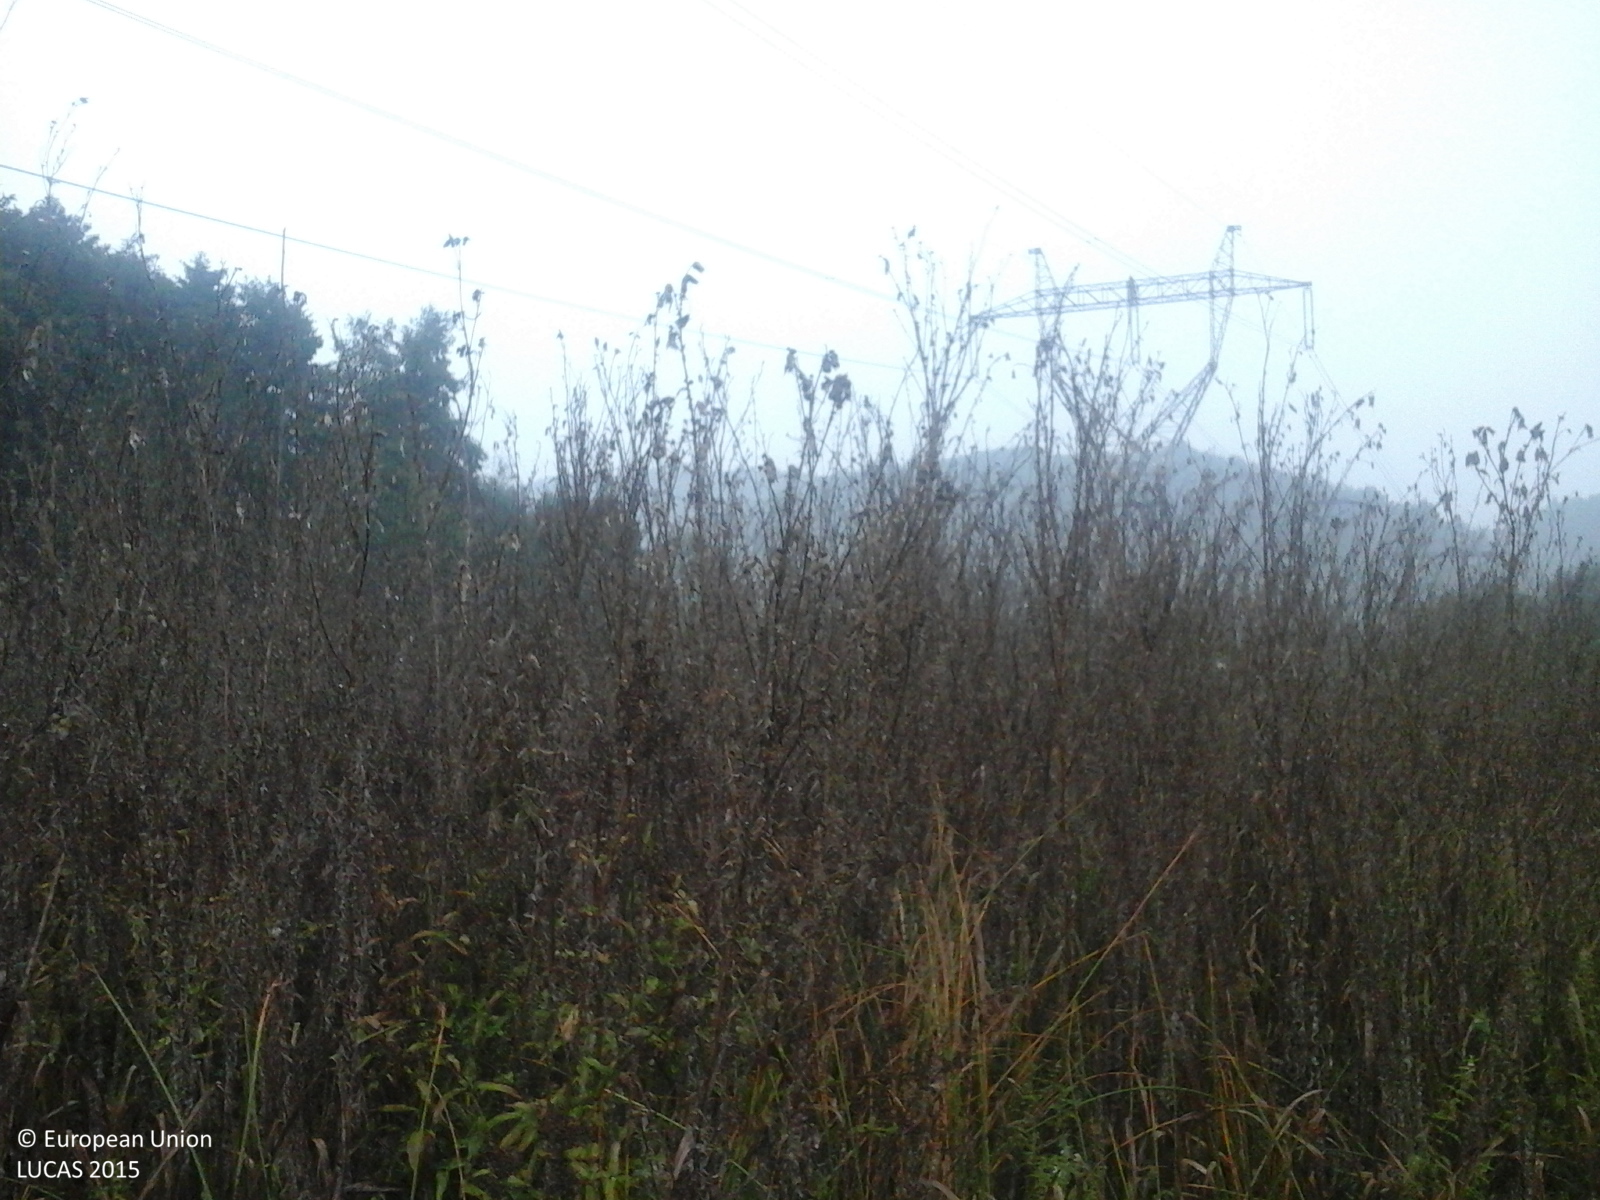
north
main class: Grassland
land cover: Spontaneously vegetated surfaces
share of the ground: > 75 %
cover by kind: herbaceous plants 100 %
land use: Agriculture (excluding fallow land and kitchen gardens)
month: September
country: RO
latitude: 44.9480
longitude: 22.8864
